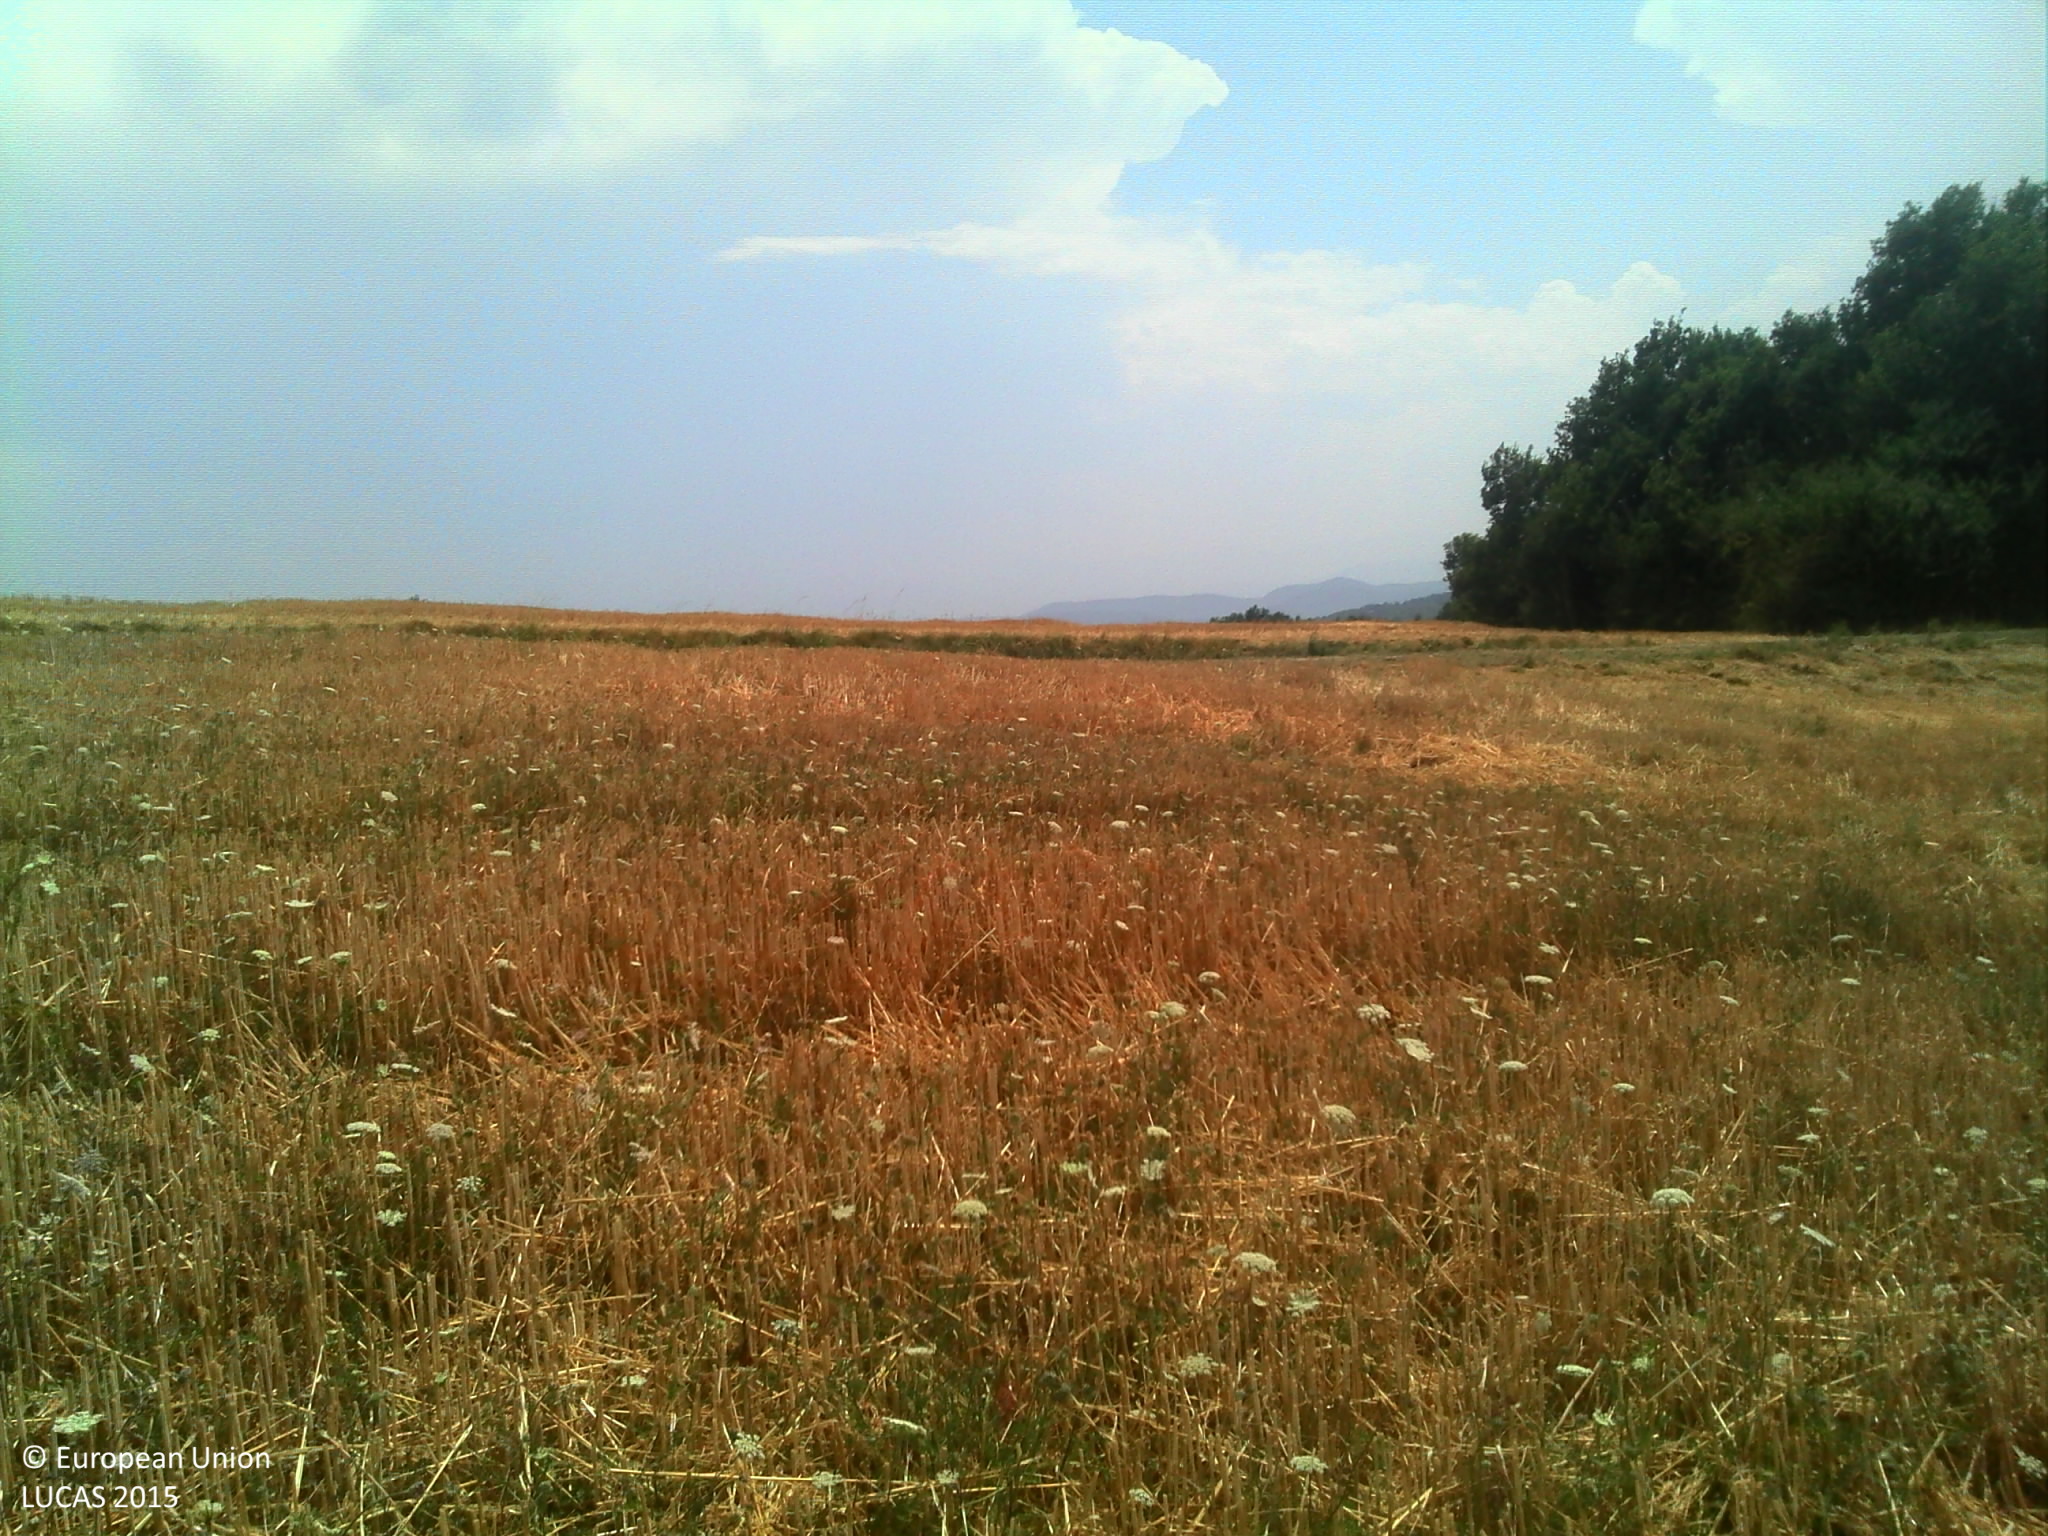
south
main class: Cropland
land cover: Barley
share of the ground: > 75 %
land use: Agriculture (excluding fallow land and kitchen gardens)
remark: Harvested field
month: July
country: FR
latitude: 43.2912
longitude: 1.0421
